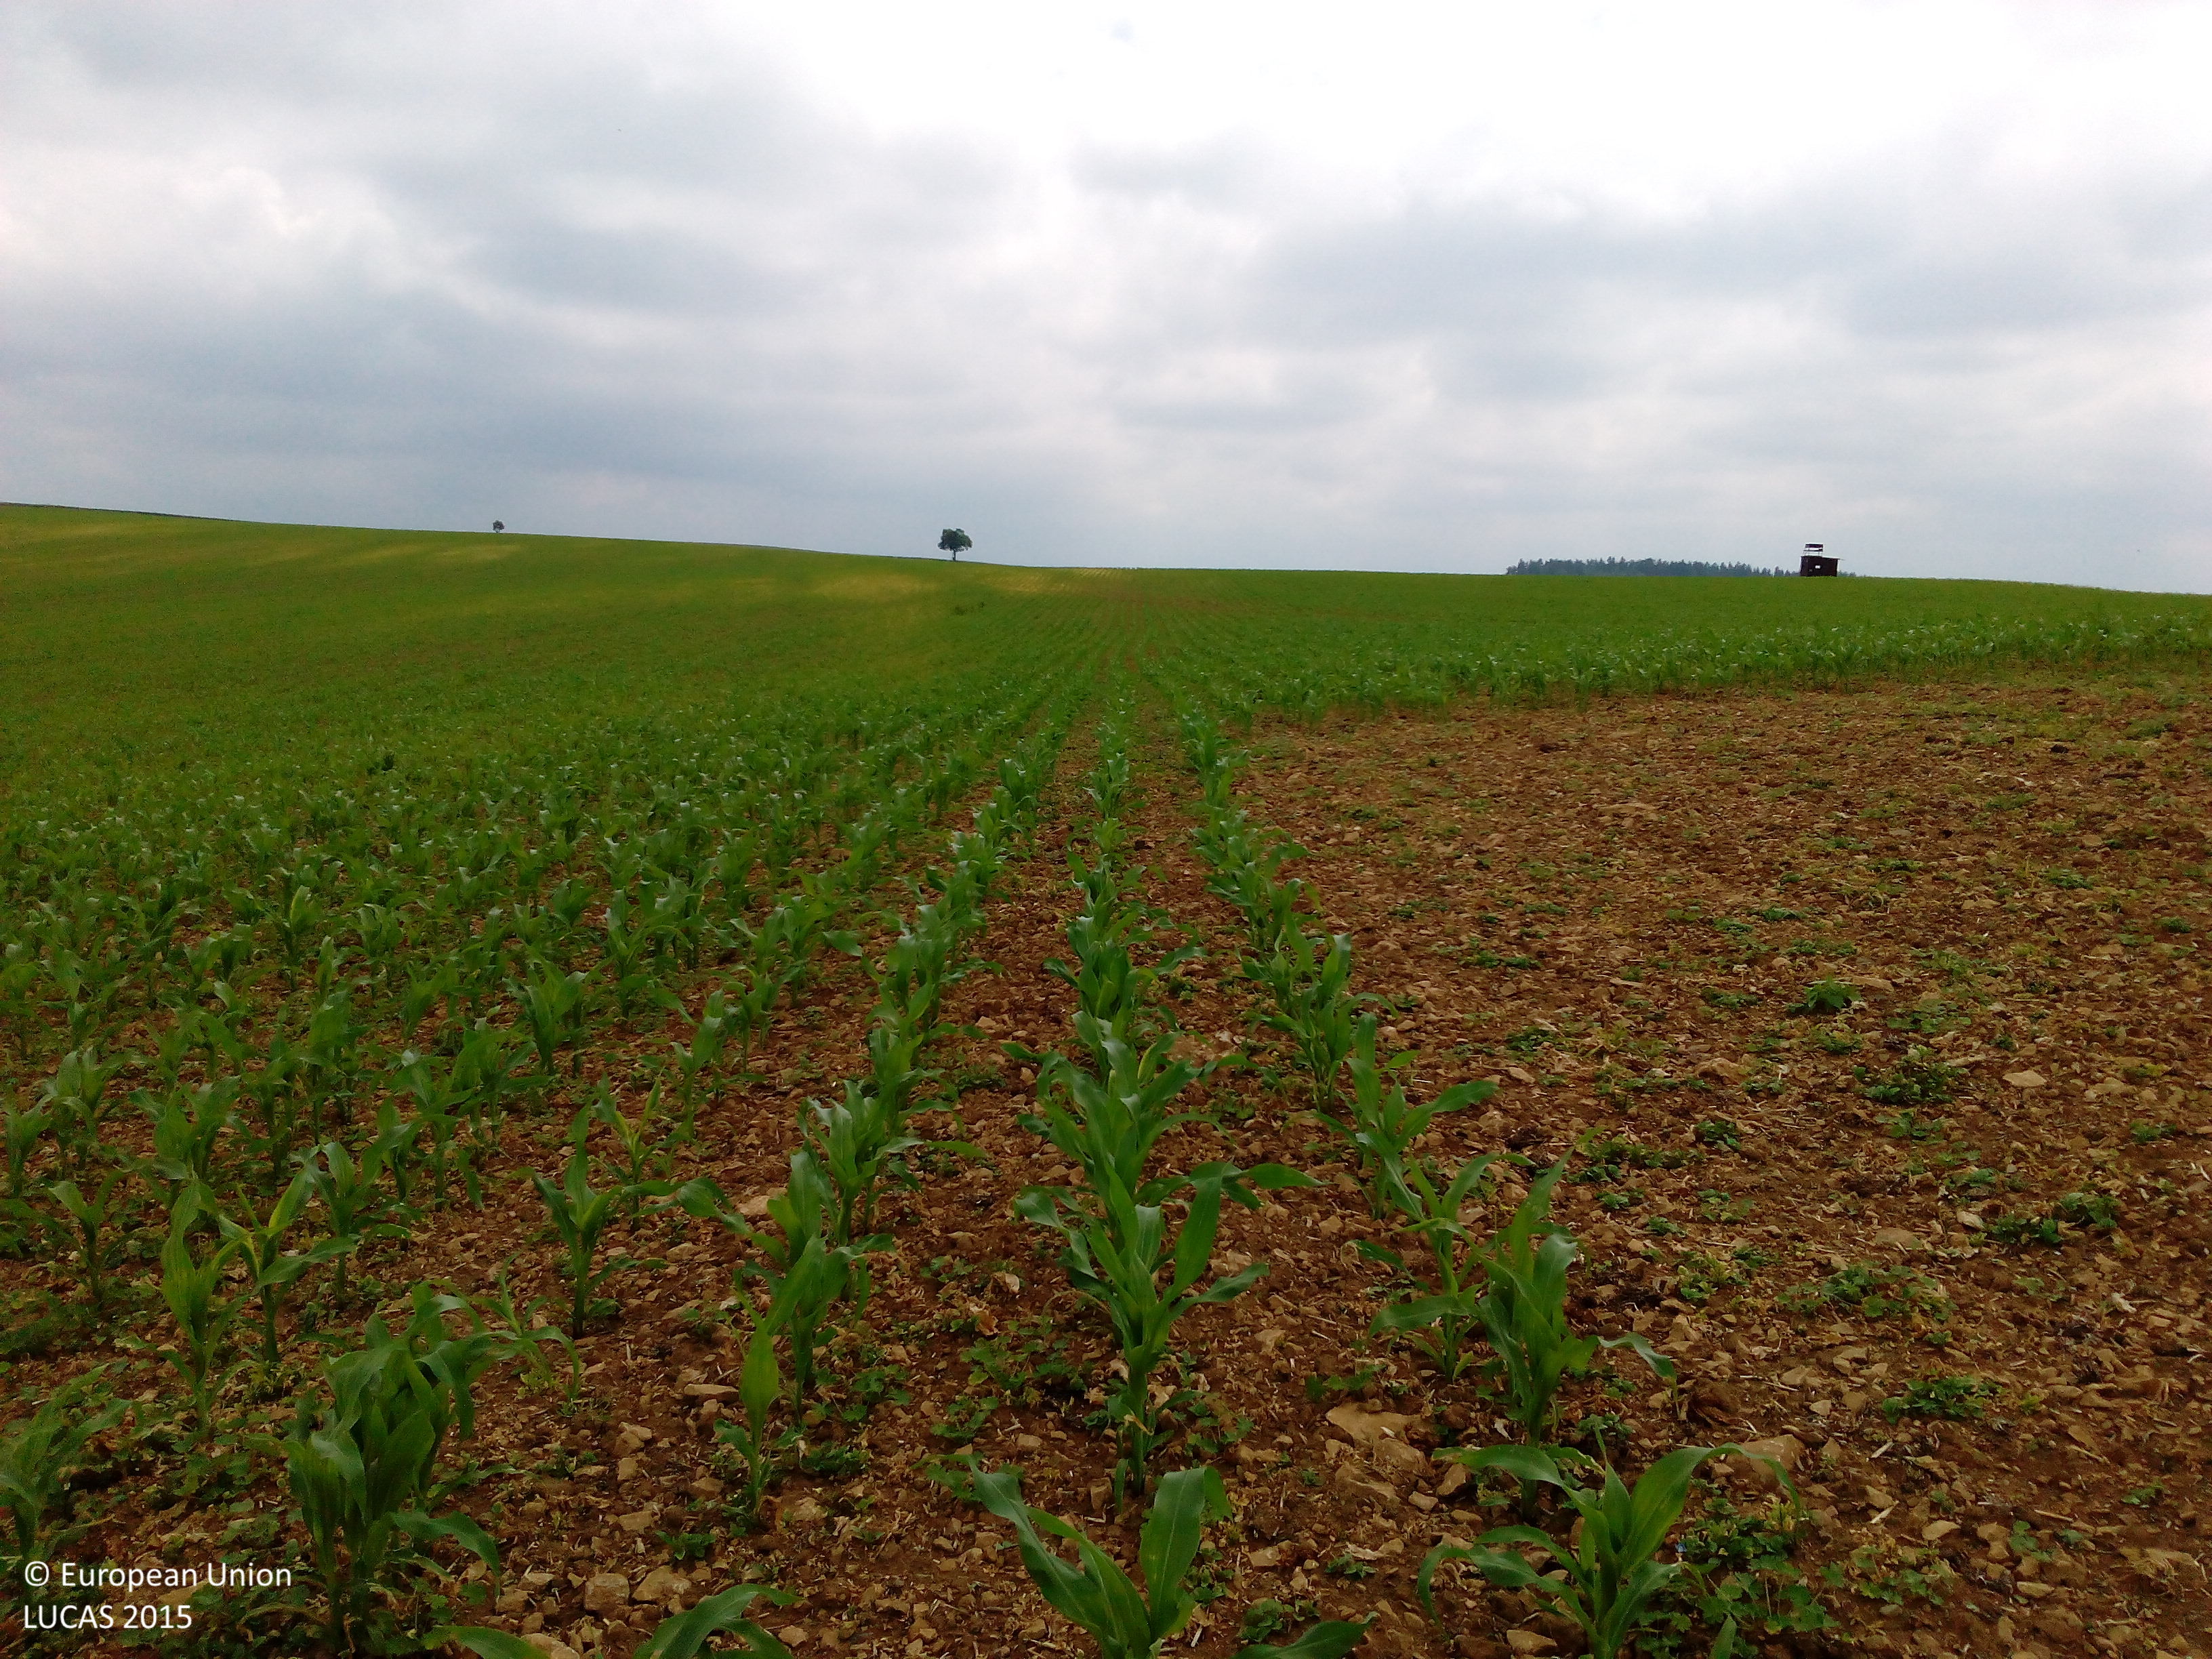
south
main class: Cropland
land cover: Maize
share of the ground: 25 - 50 %
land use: Agriculture (excluding fallow land and kitchen gardens)
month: June
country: DE
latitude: 50.6414
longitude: 11.5410
